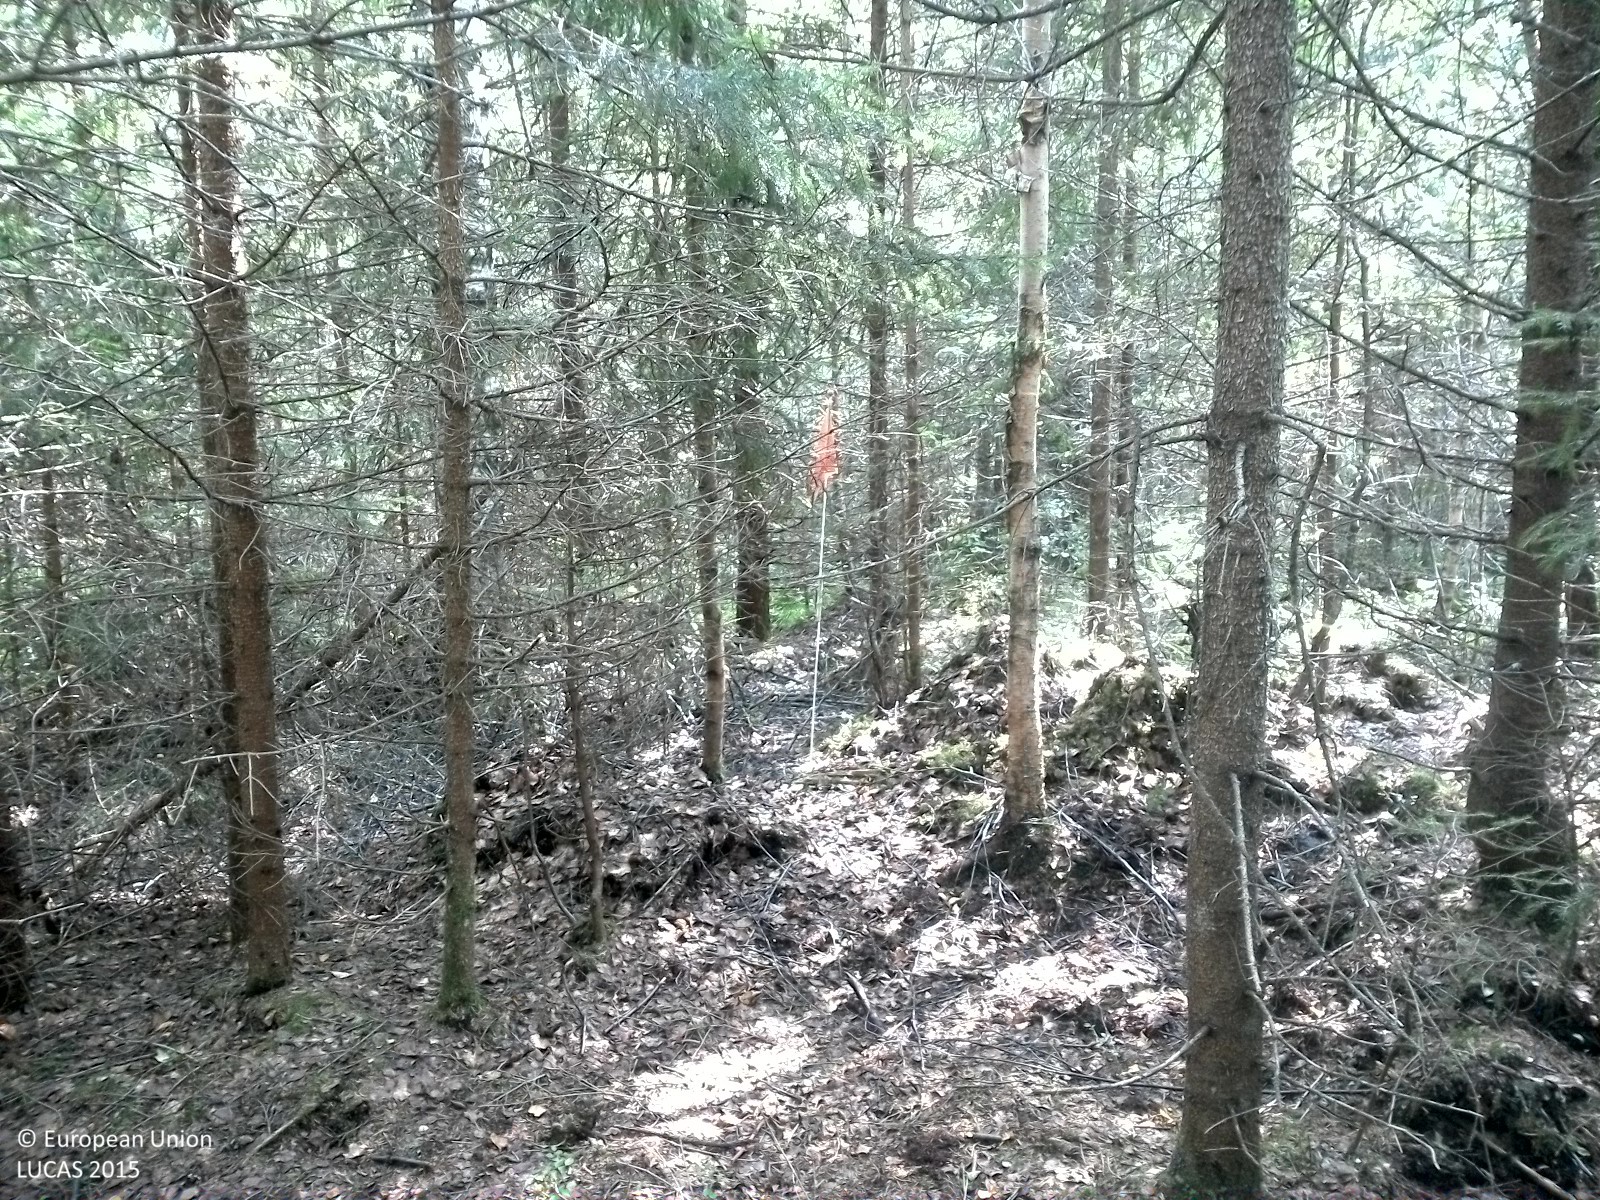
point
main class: Woodland
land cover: Spruce dominated mixed woodland
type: boreal forest
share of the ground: 50 - 75 %
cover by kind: coniferous forest trees 40 %, broadleaved forest trees 25 %, consolidated bare surface 20 %, lichens and mosses 10 %, herbaceous plants 5 %
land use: Forestry
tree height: < 5 m
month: August
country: SE
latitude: 59.0856
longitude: 15.3846
